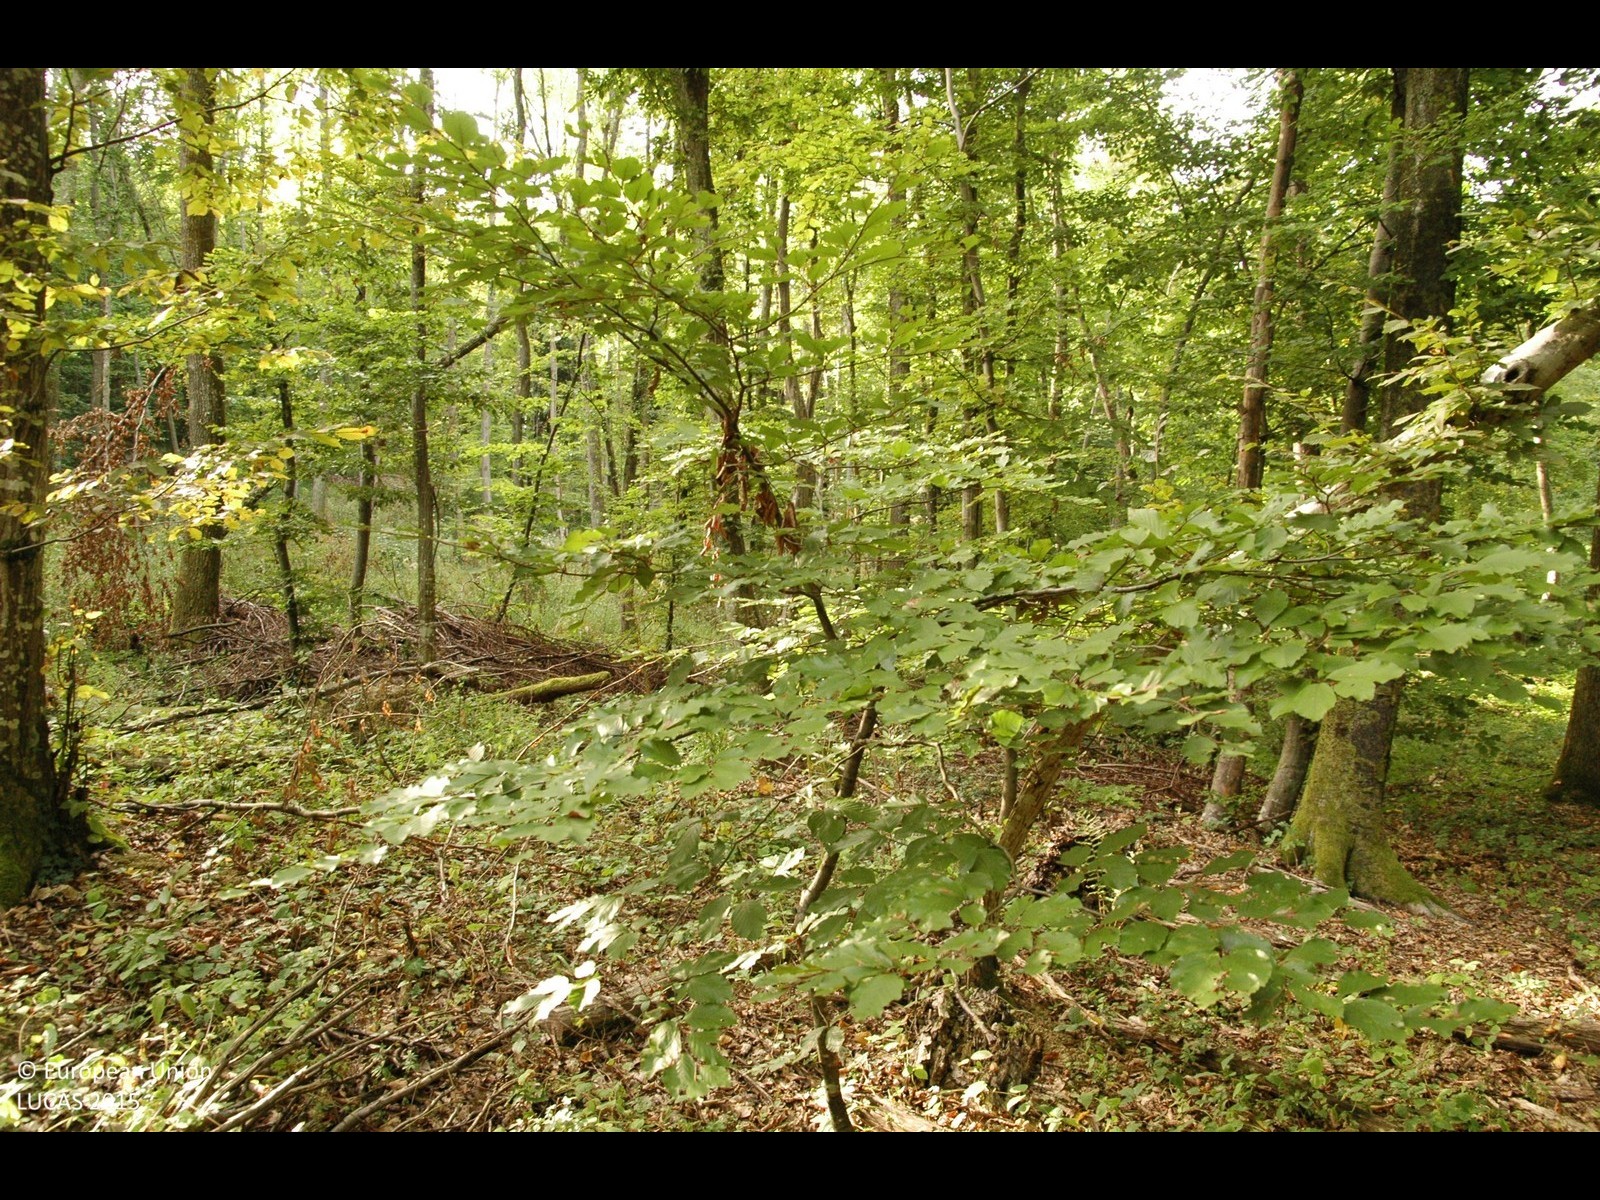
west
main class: Woodland
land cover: Broadleaved woodland
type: mesophytic deciduous forest
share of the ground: > 75 %
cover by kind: broadleaved forest trees 100 %
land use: Forestry
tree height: > 5 m
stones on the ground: < 10 %
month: September
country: HR
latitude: 45.6472
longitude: 15.8867
